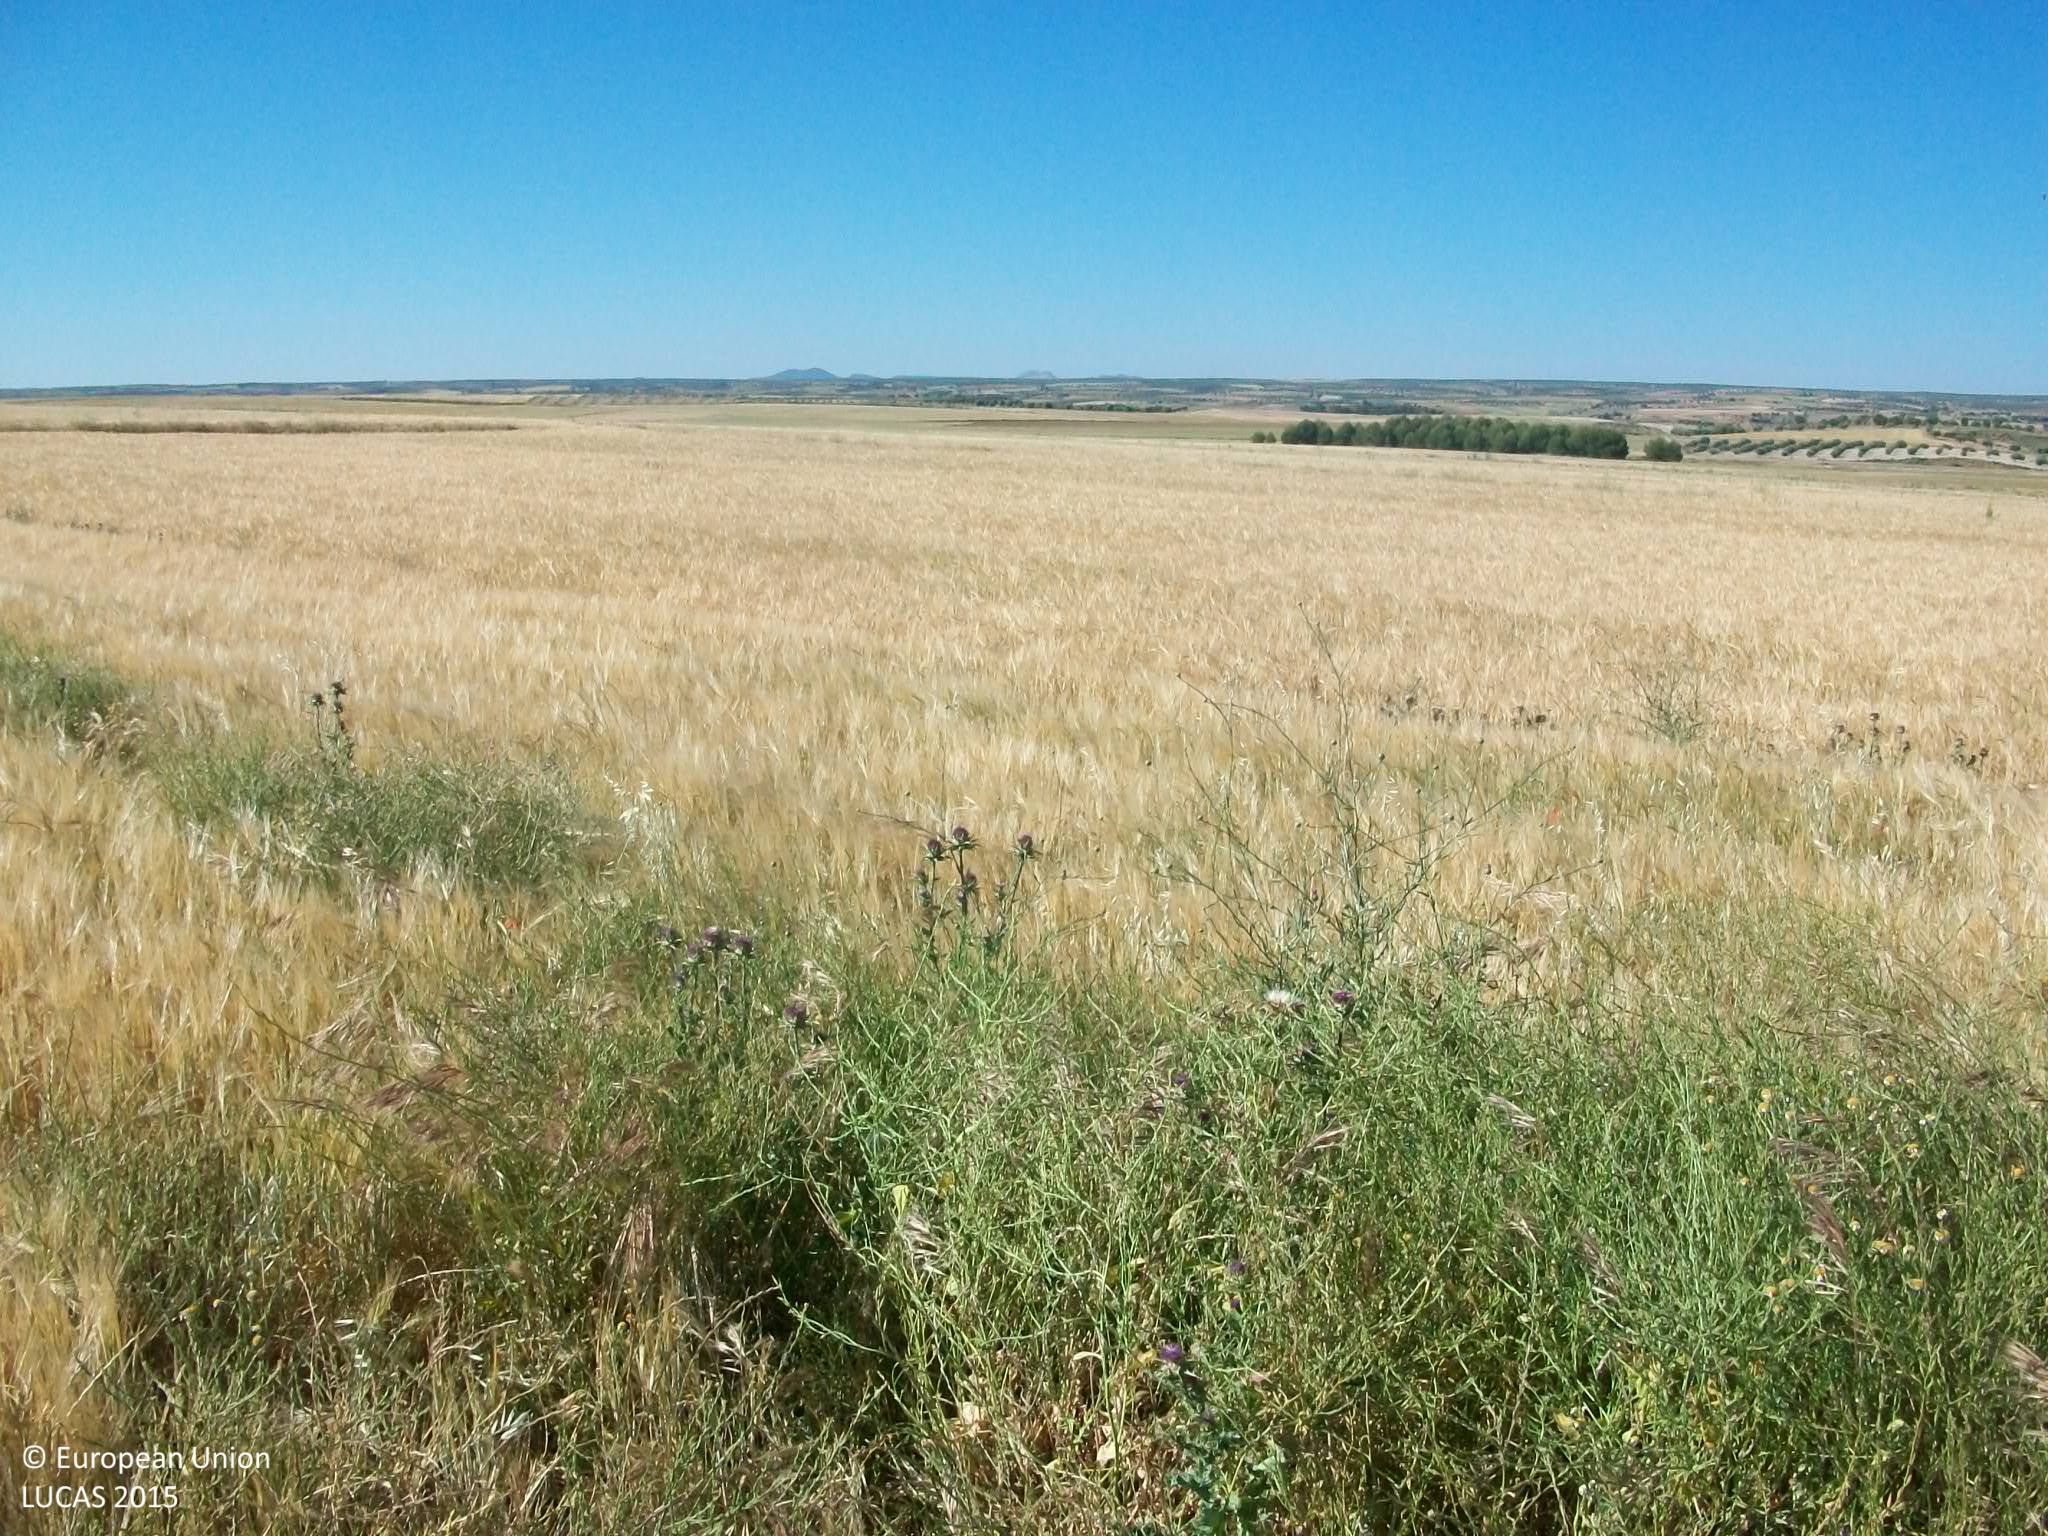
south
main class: Cropland
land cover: Barley
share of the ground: > 75 %
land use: Agriculture (excluding fallow land and kitchen gardens)
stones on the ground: 10 - 25 %
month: May
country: ES
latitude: 39.8875
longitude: -3.7009
